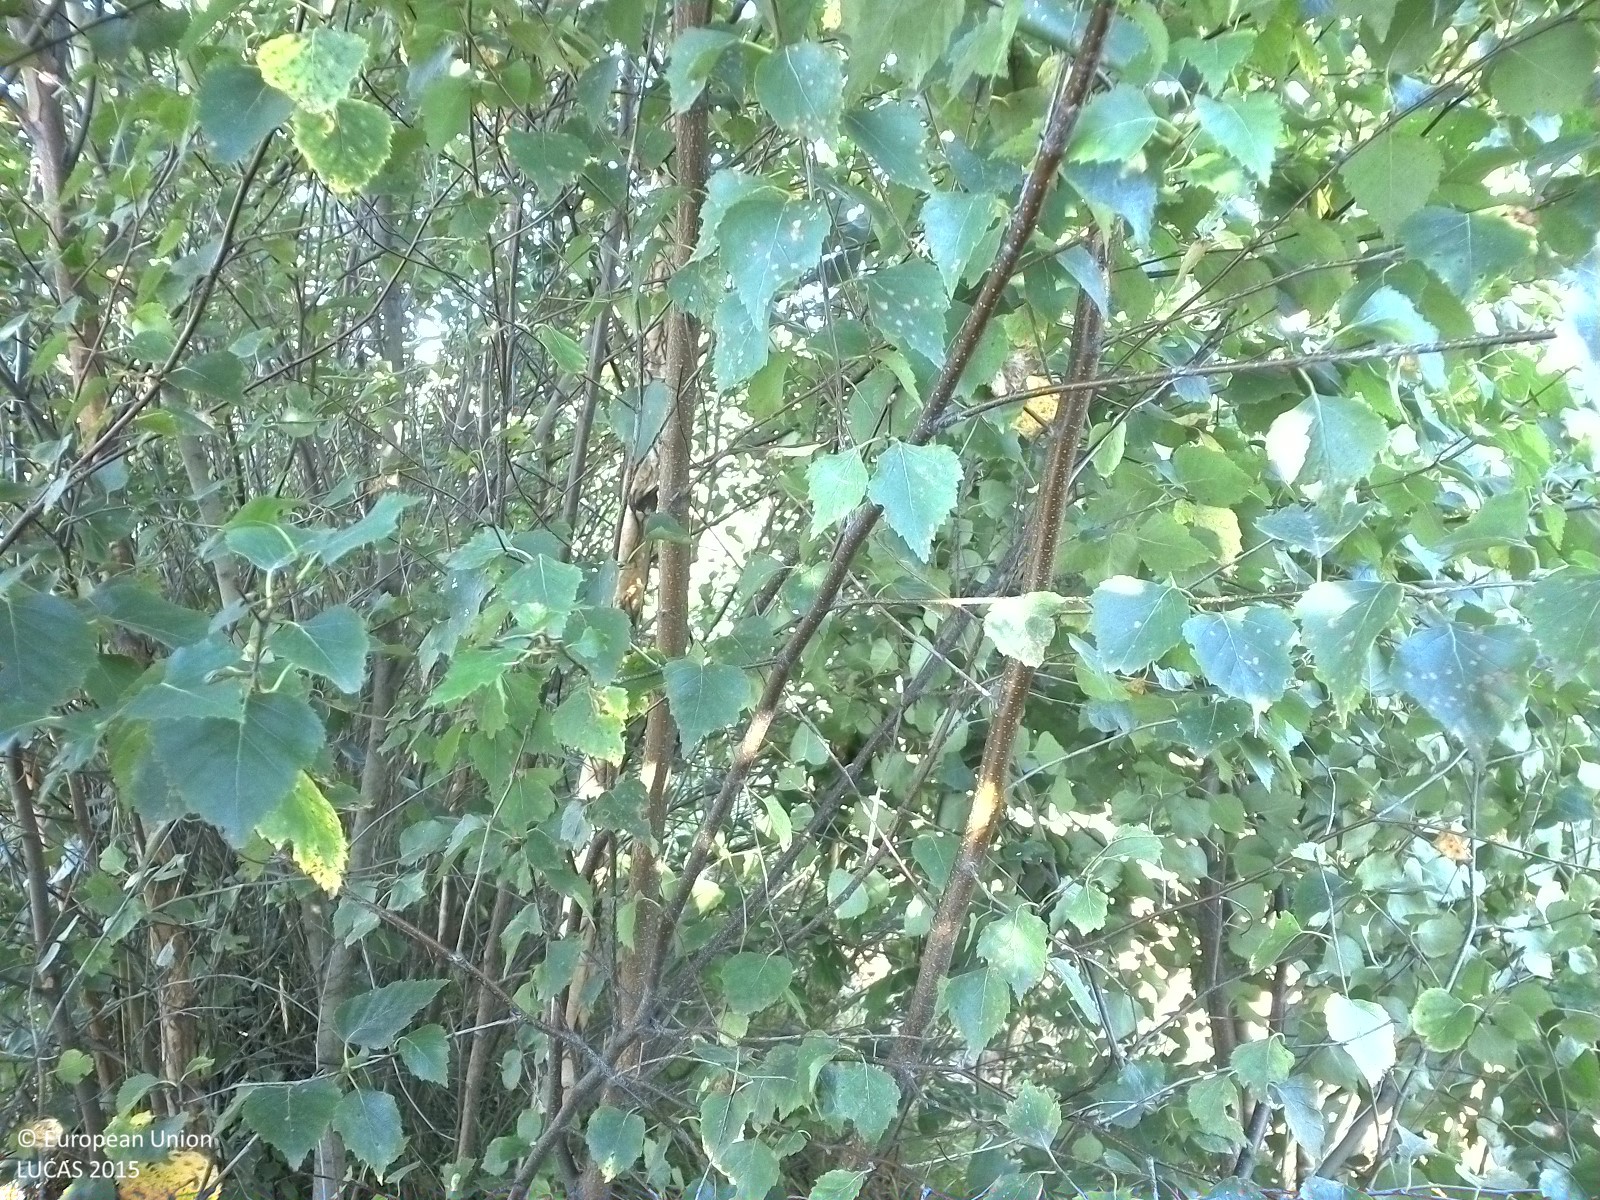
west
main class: Woodland
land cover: Broadleaved woodland
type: hemiboreal forest and nemoral coniferous forest and mixed broadleaved-coniferous forest
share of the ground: 50 - 75 %
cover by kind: broadleaved forest trees 70 %, herbaceous plants 30 %
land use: Semi-natural and natural areas not in use
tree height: < 5 m
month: August
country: SE
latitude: 59.2397
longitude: 15.1278
